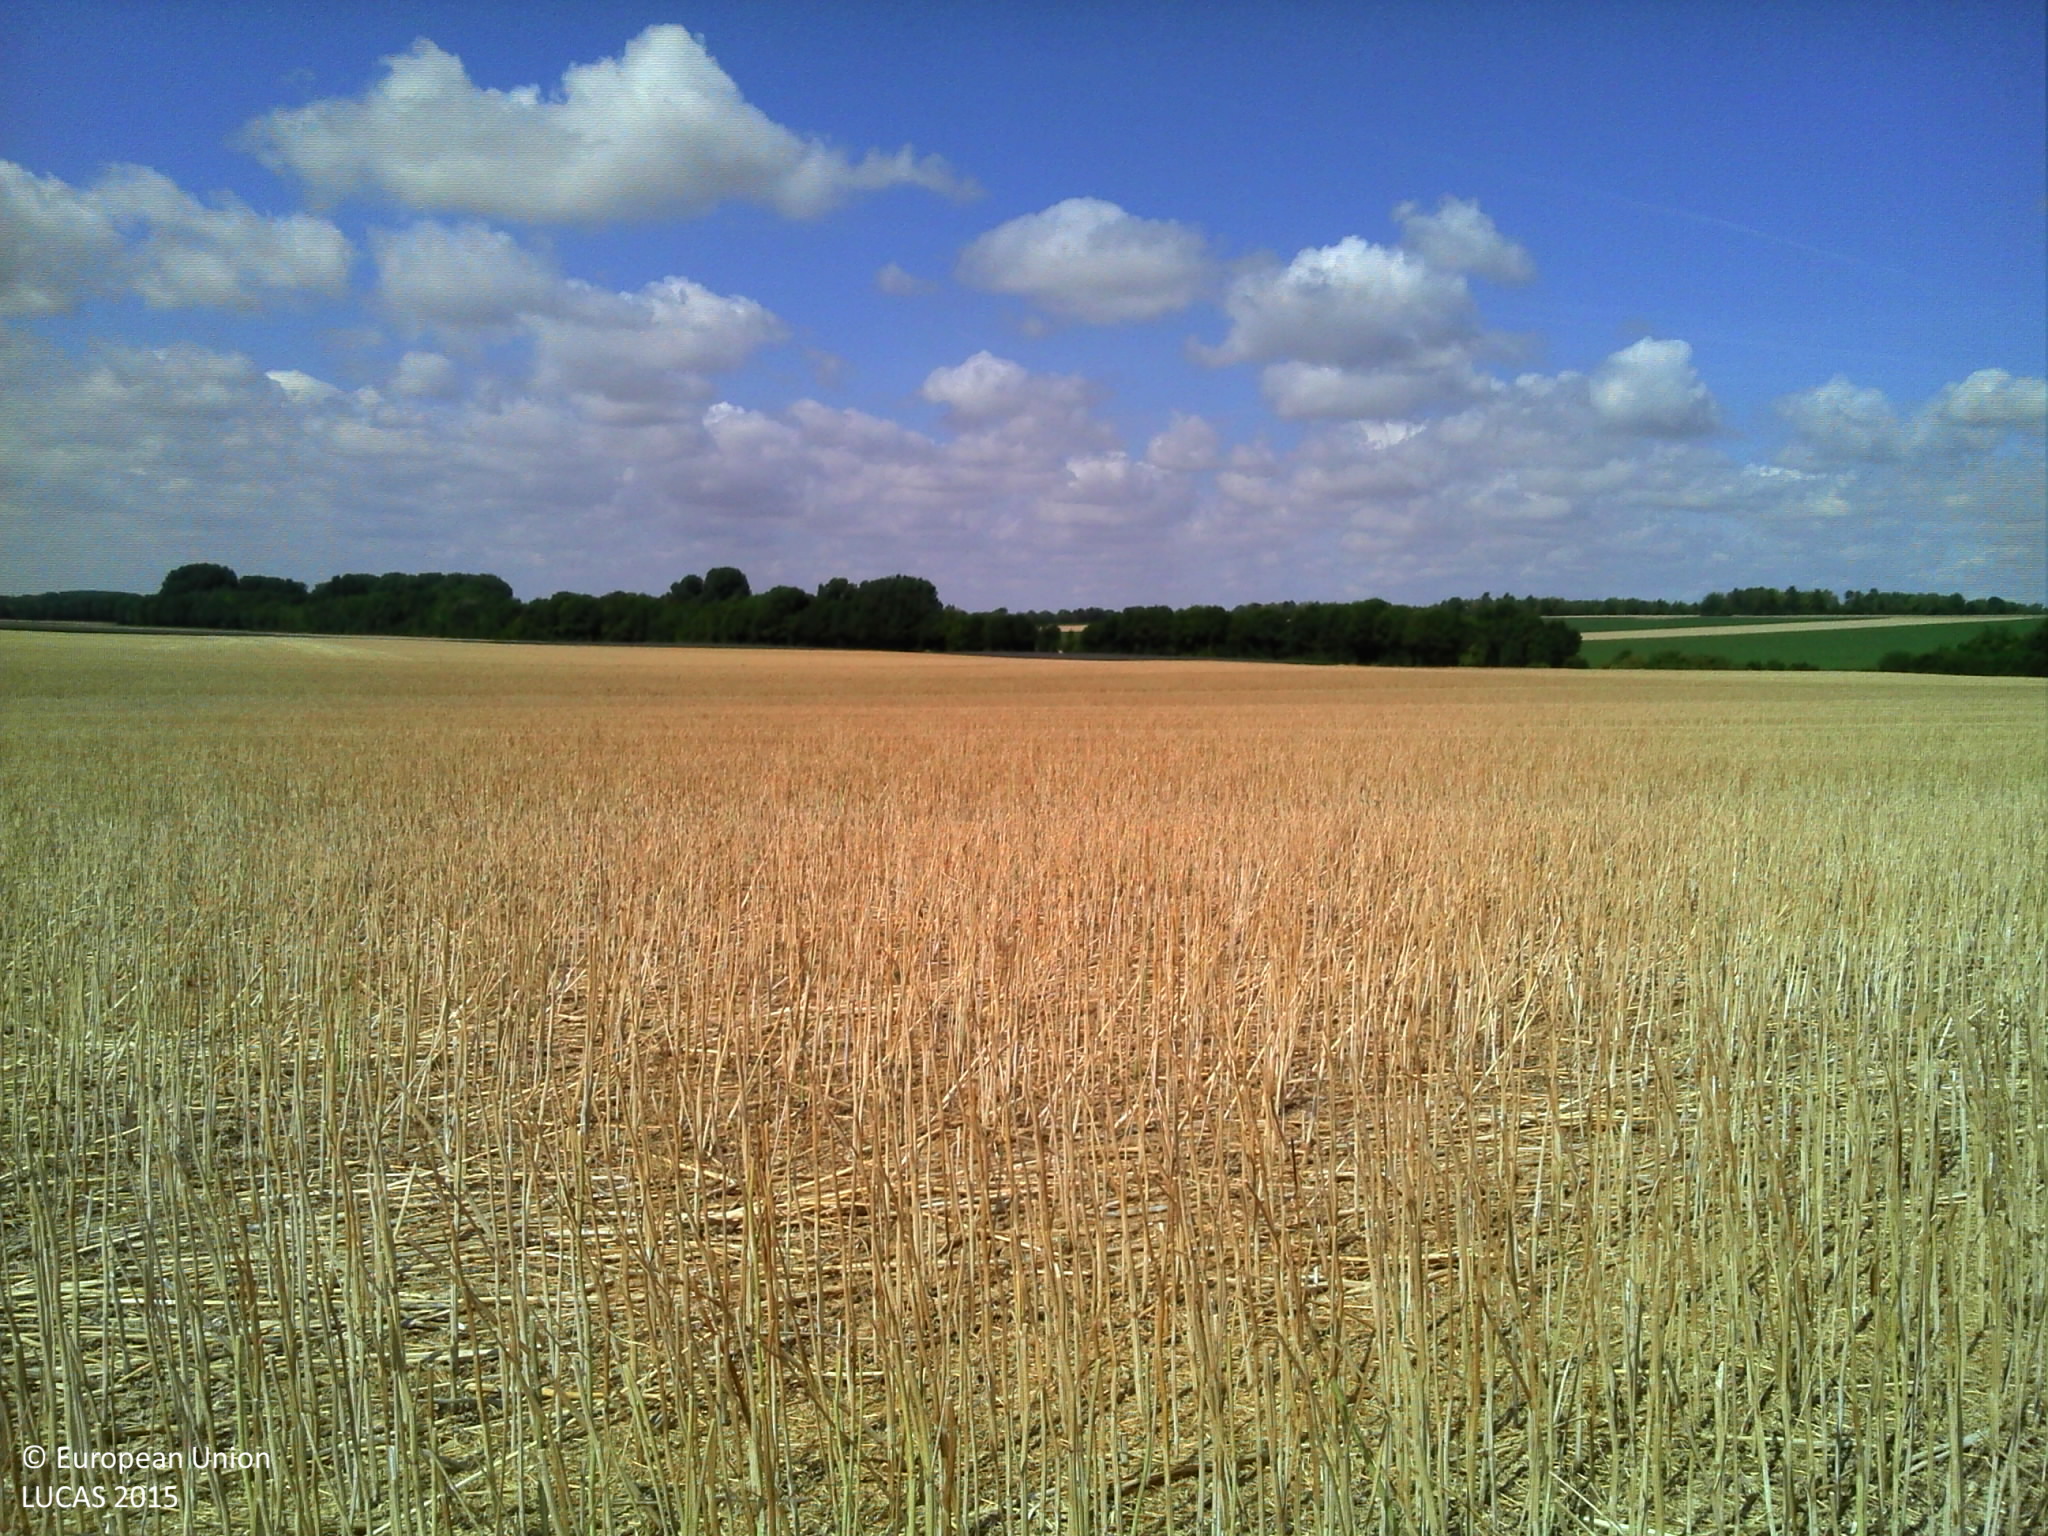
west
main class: Cropland
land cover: Rape and turnip rape
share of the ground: > 75 %
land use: Agriculture (excluding fallow land and kitchen gardens)
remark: Harvested field
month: July
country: FR
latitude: 49.3377
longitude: 4.2843
